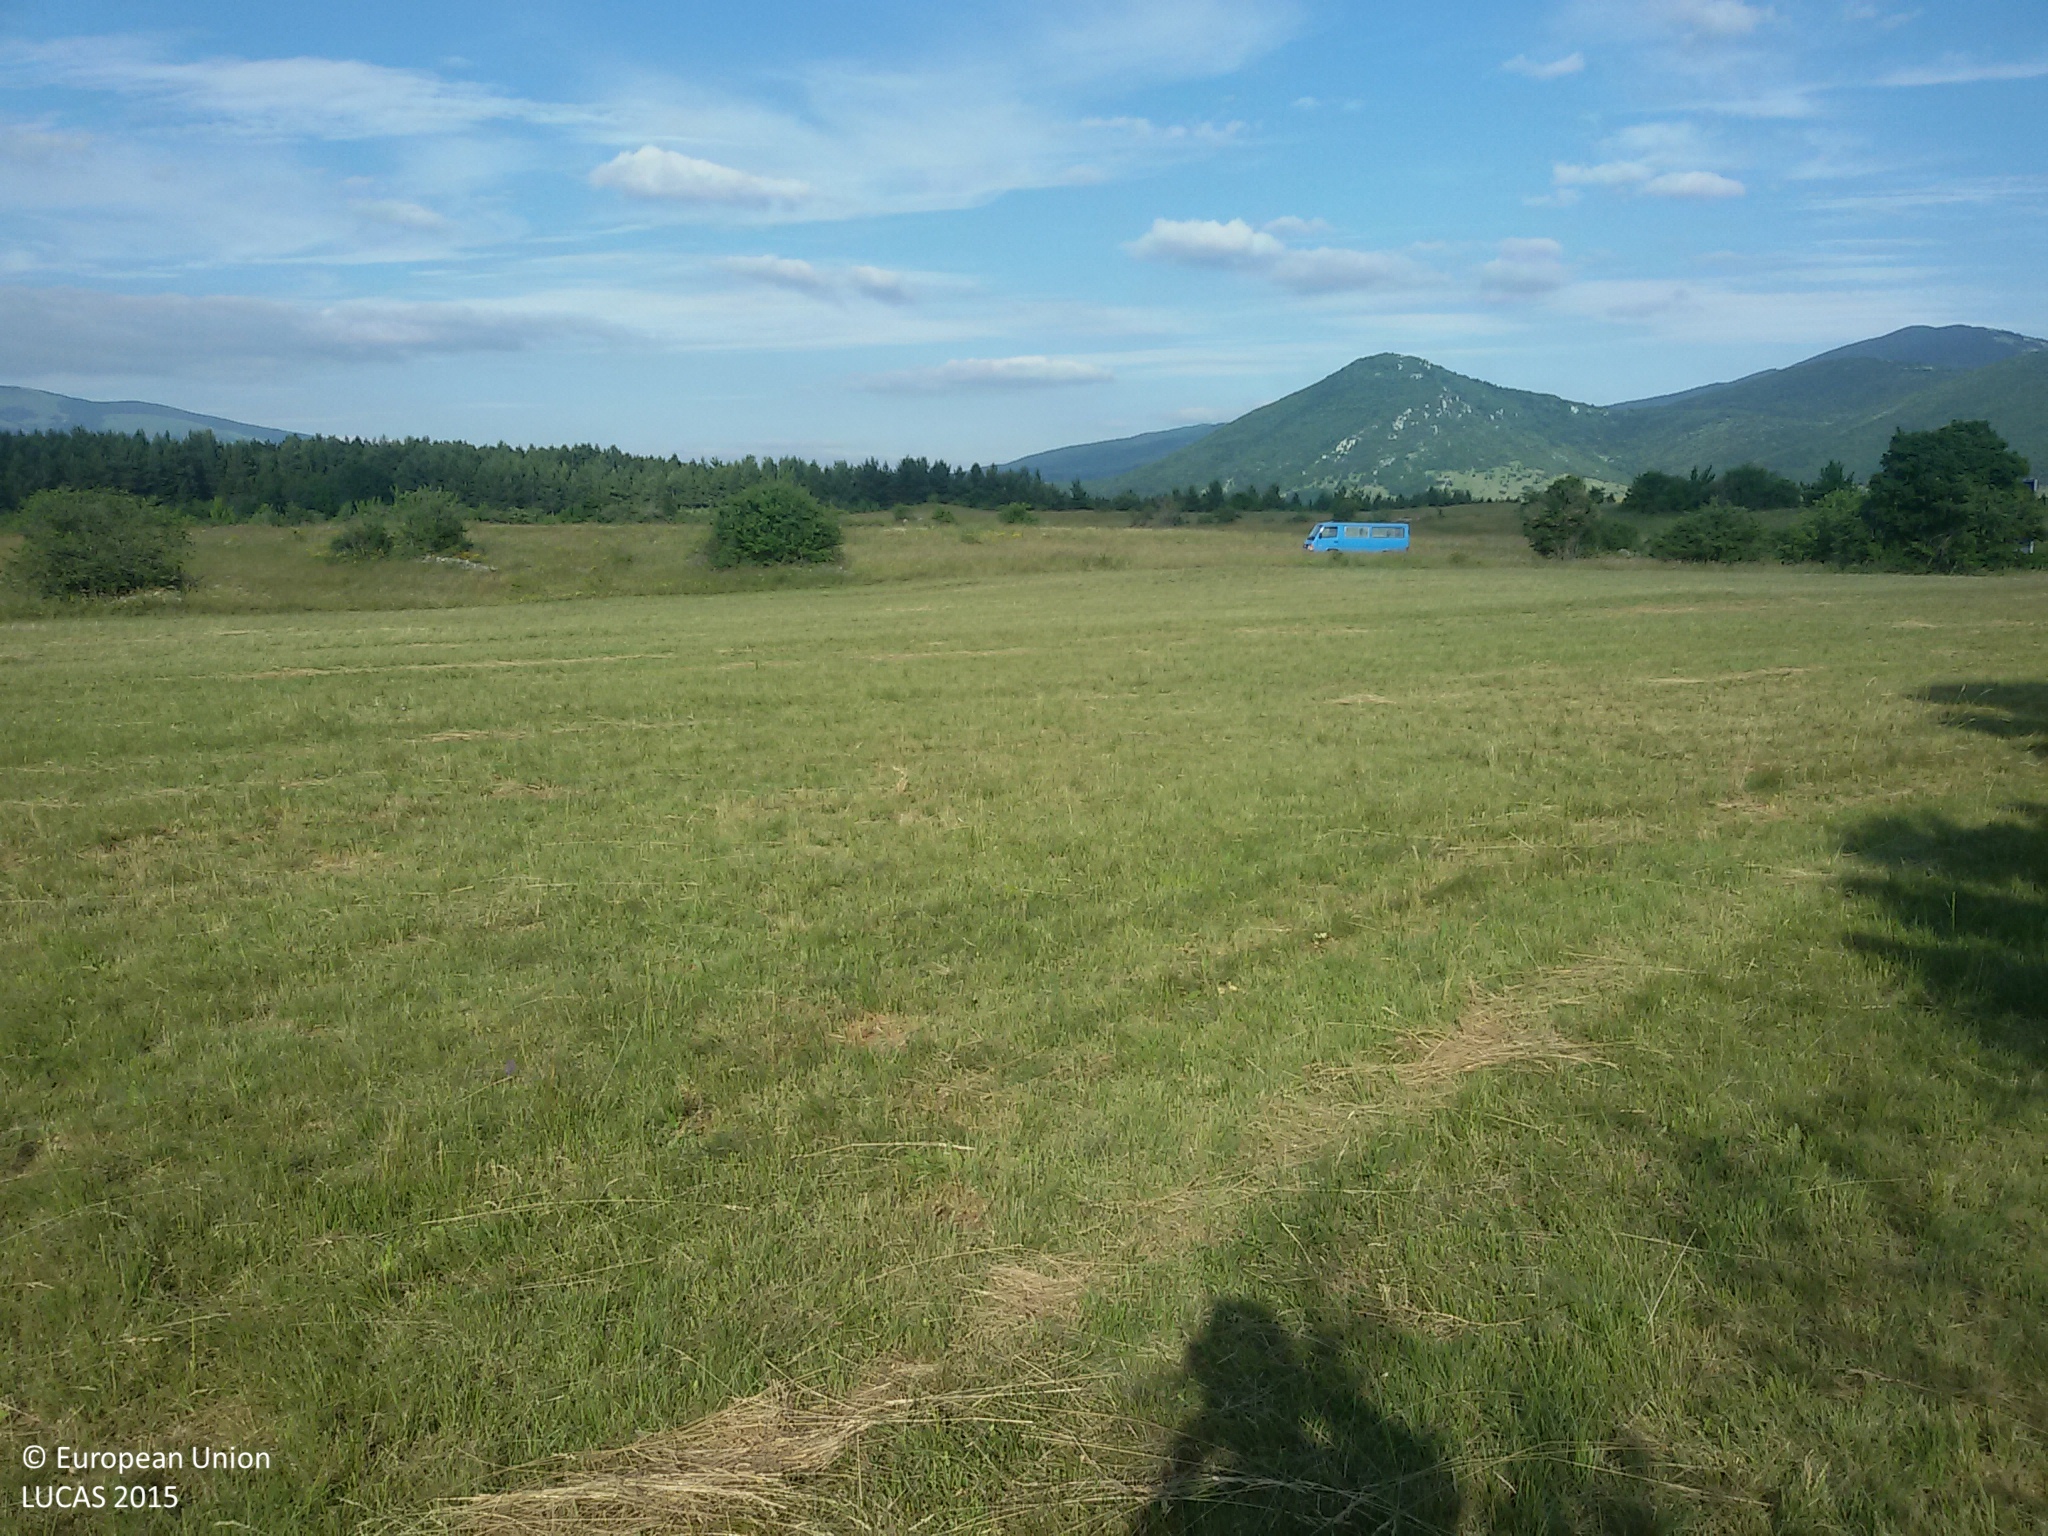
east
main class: Grassland
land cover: Grassland without tree/shrub cover
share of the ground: > 75 %
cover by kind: herbaceous plants 95 %, unconsolidated bare surface 5 %
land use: Agriculture (excluding fallow land and kitchen gardens)
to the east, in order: Grassland without tree/shrub cover; Tracks; Grassland with sparse tree/shrub cover; Dry stone walls; Grassland with sparse tree/shrub cover; Grassland without tree/shrub cover; Paved roads, cycling and walking lanes; Grassland without tree/shrub cover; Shruby margins; Dry stone walls; Shruby margins; Grassland without tree/shrub cover
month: June
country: HR
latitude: 44.5169
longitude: 15.7429
